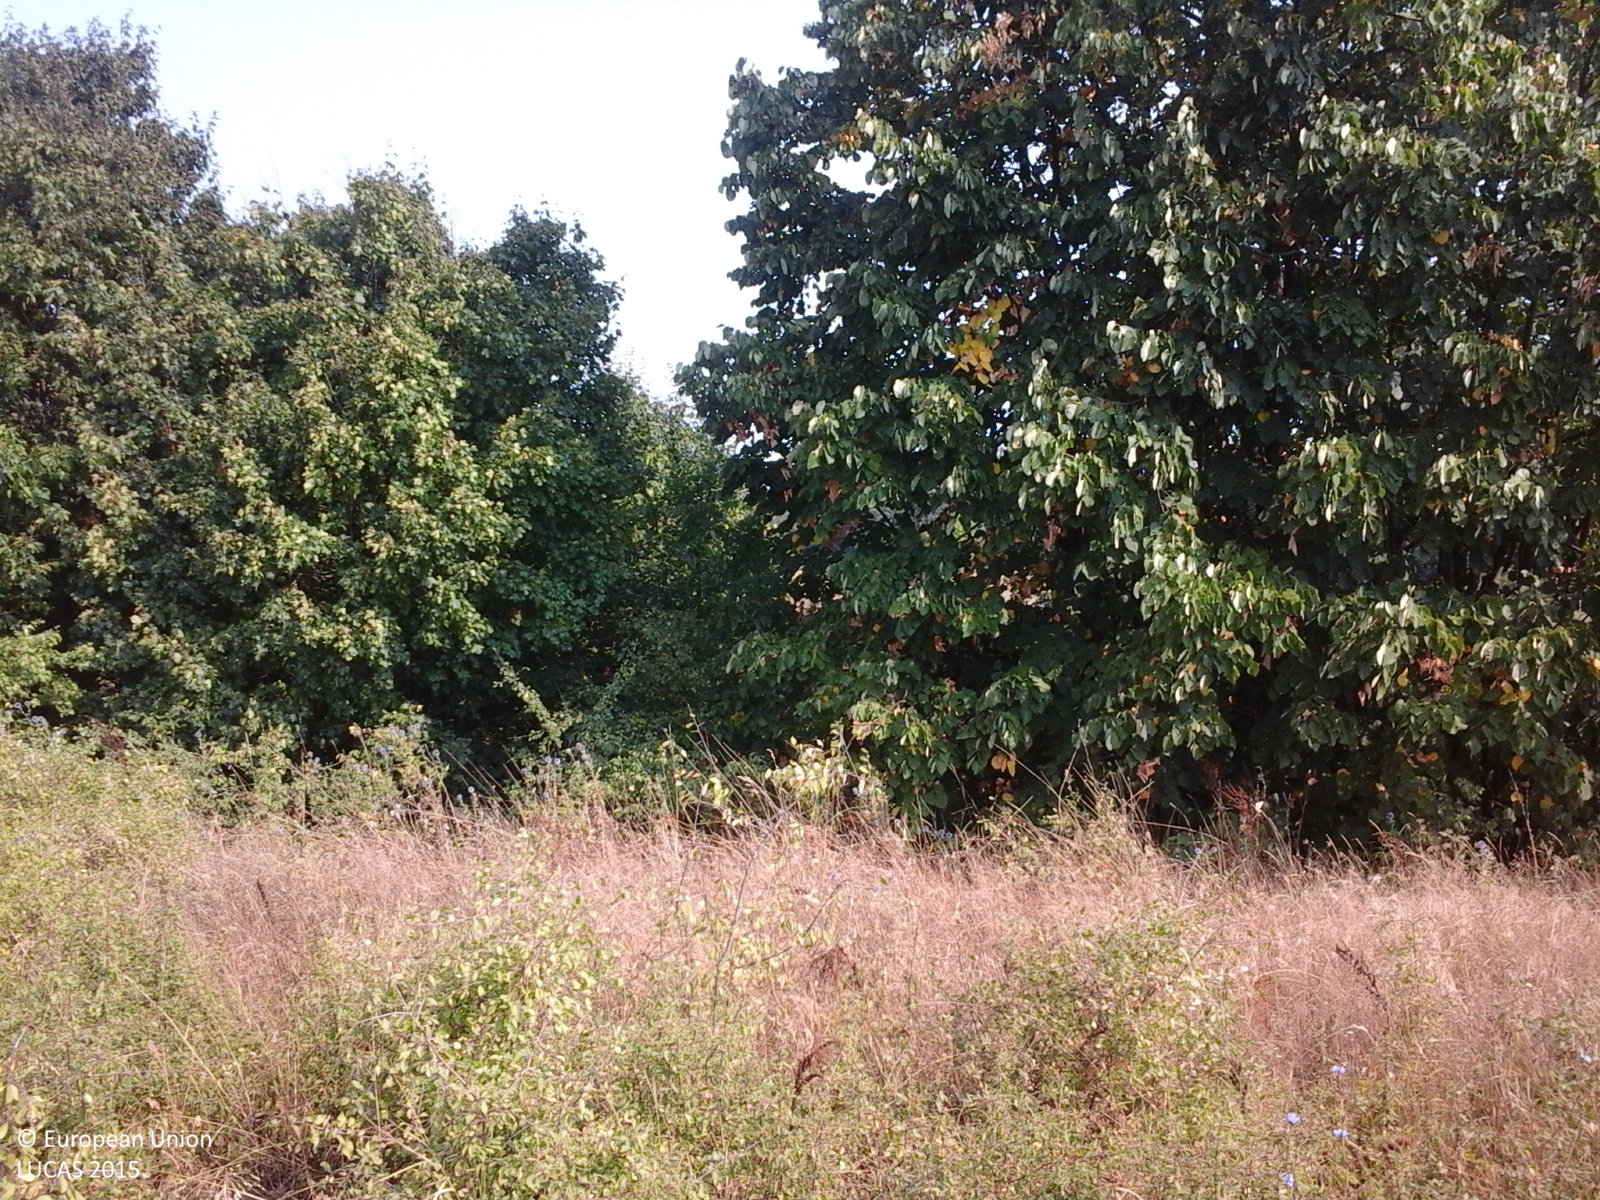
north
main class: Grassland
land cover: Spontaneously vegetated surfaces
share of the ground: > 75 %
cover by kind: herbaceous plants 100 %
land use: Fallow land
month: August
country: RO
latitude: 44.2474
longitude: 23.5137
